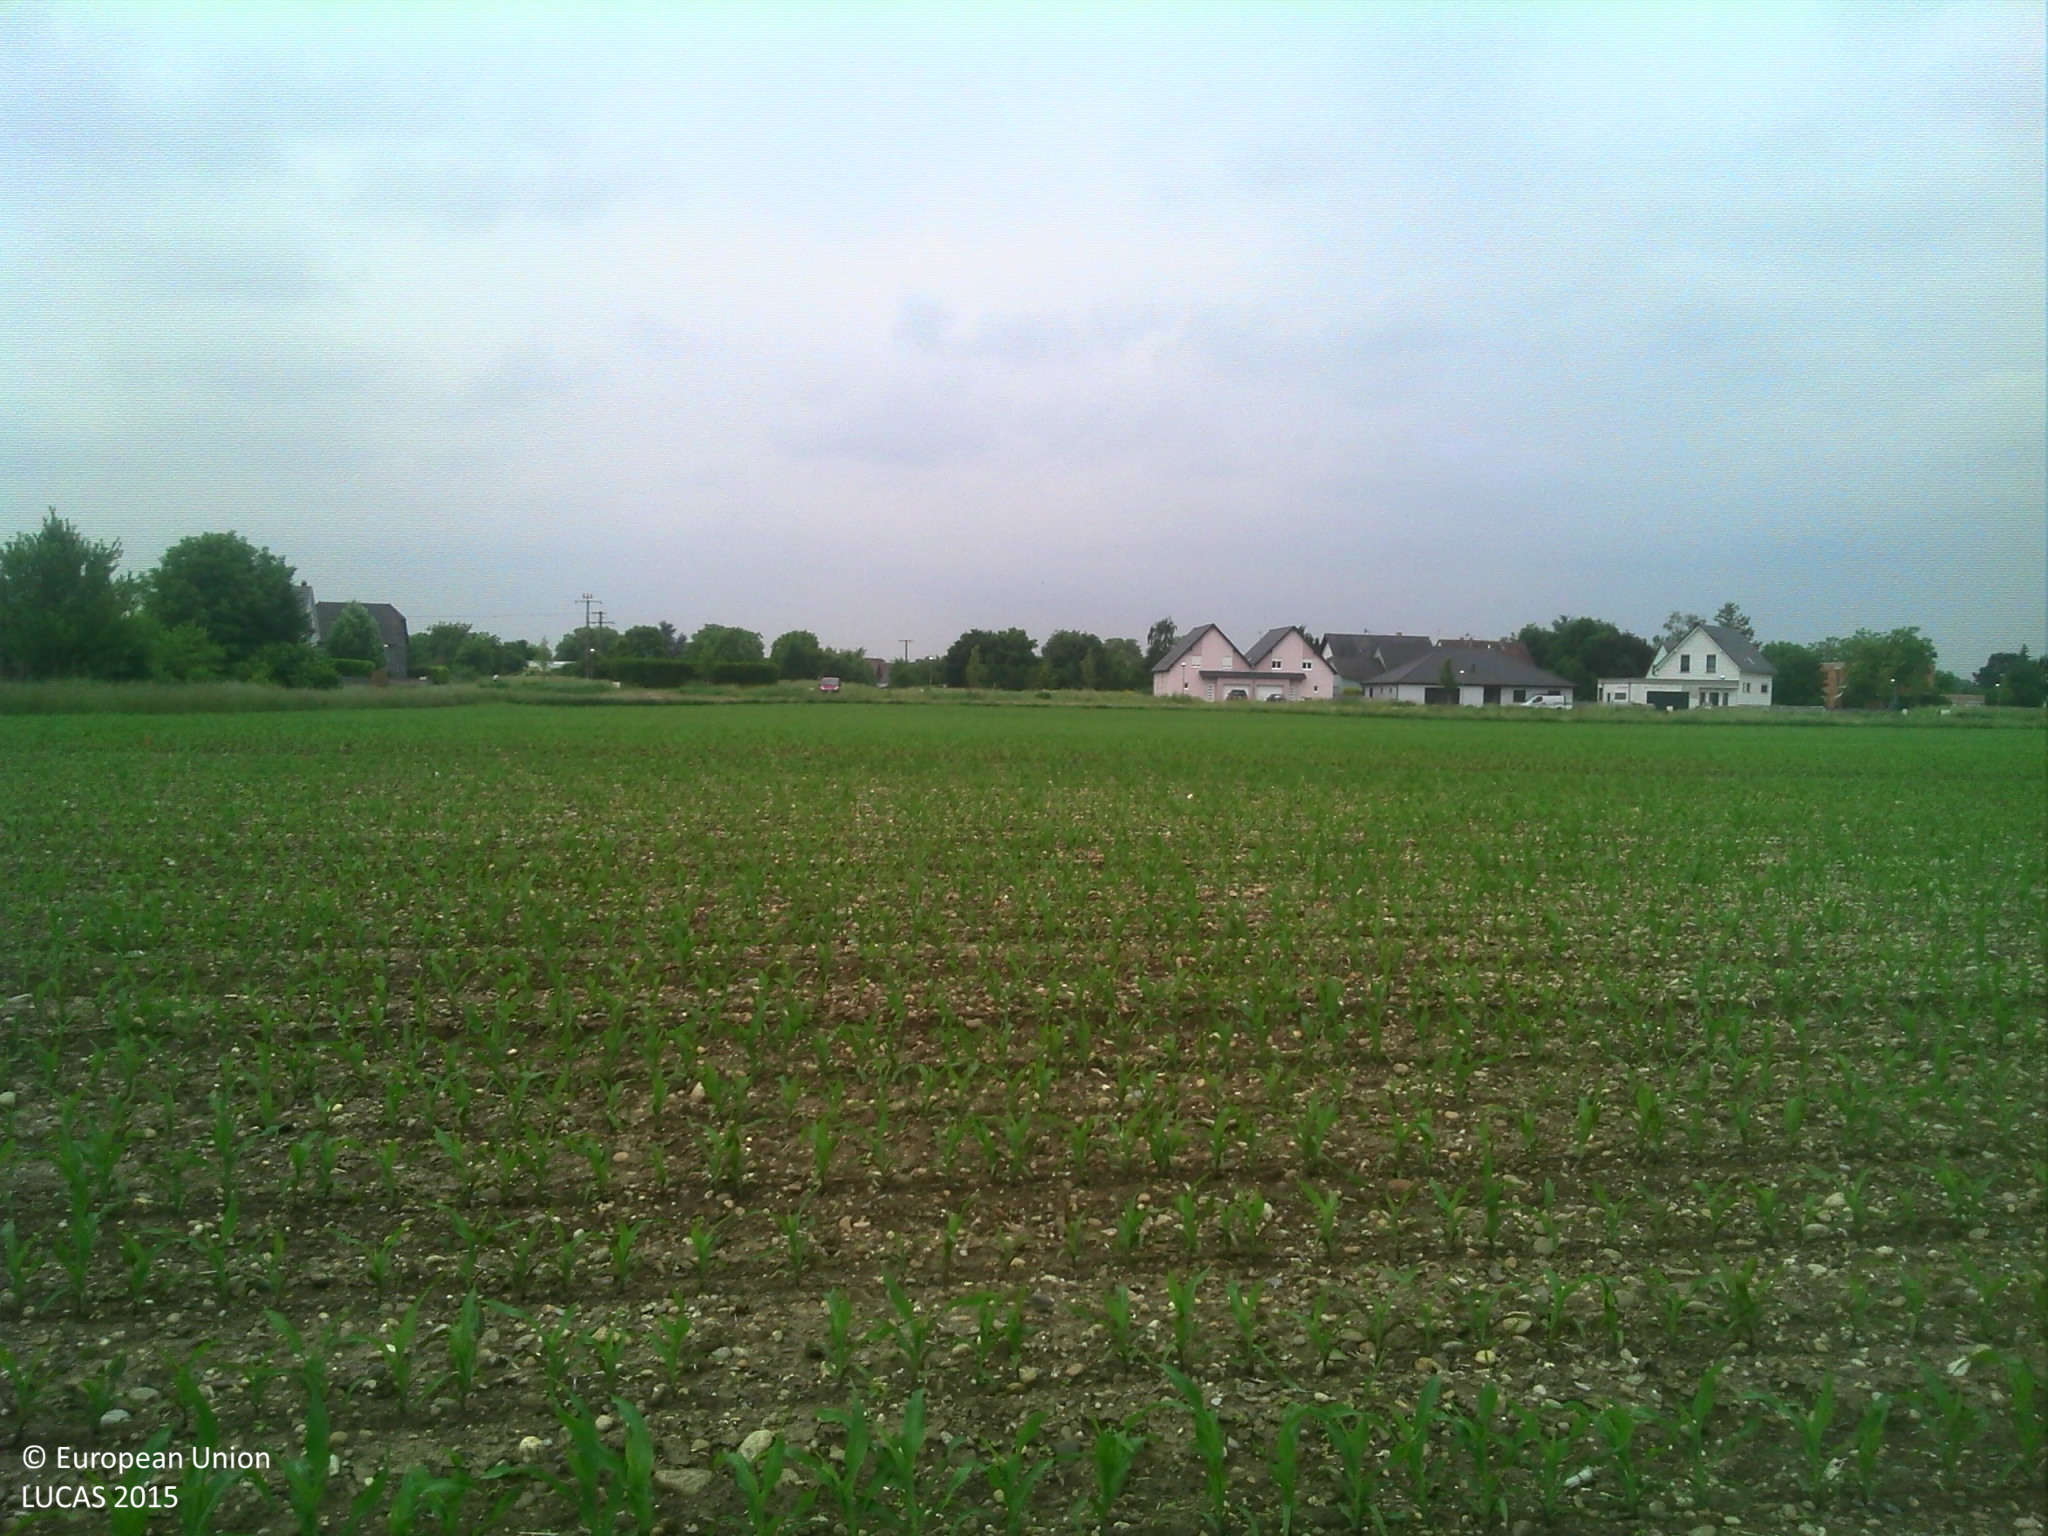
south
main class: Cropland
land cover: Maize
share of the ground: > 75 %
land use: Agriculture (excluding fallow land and kitchen gardens)
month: May
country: FR
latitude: 48.2692
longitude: 7.5894
